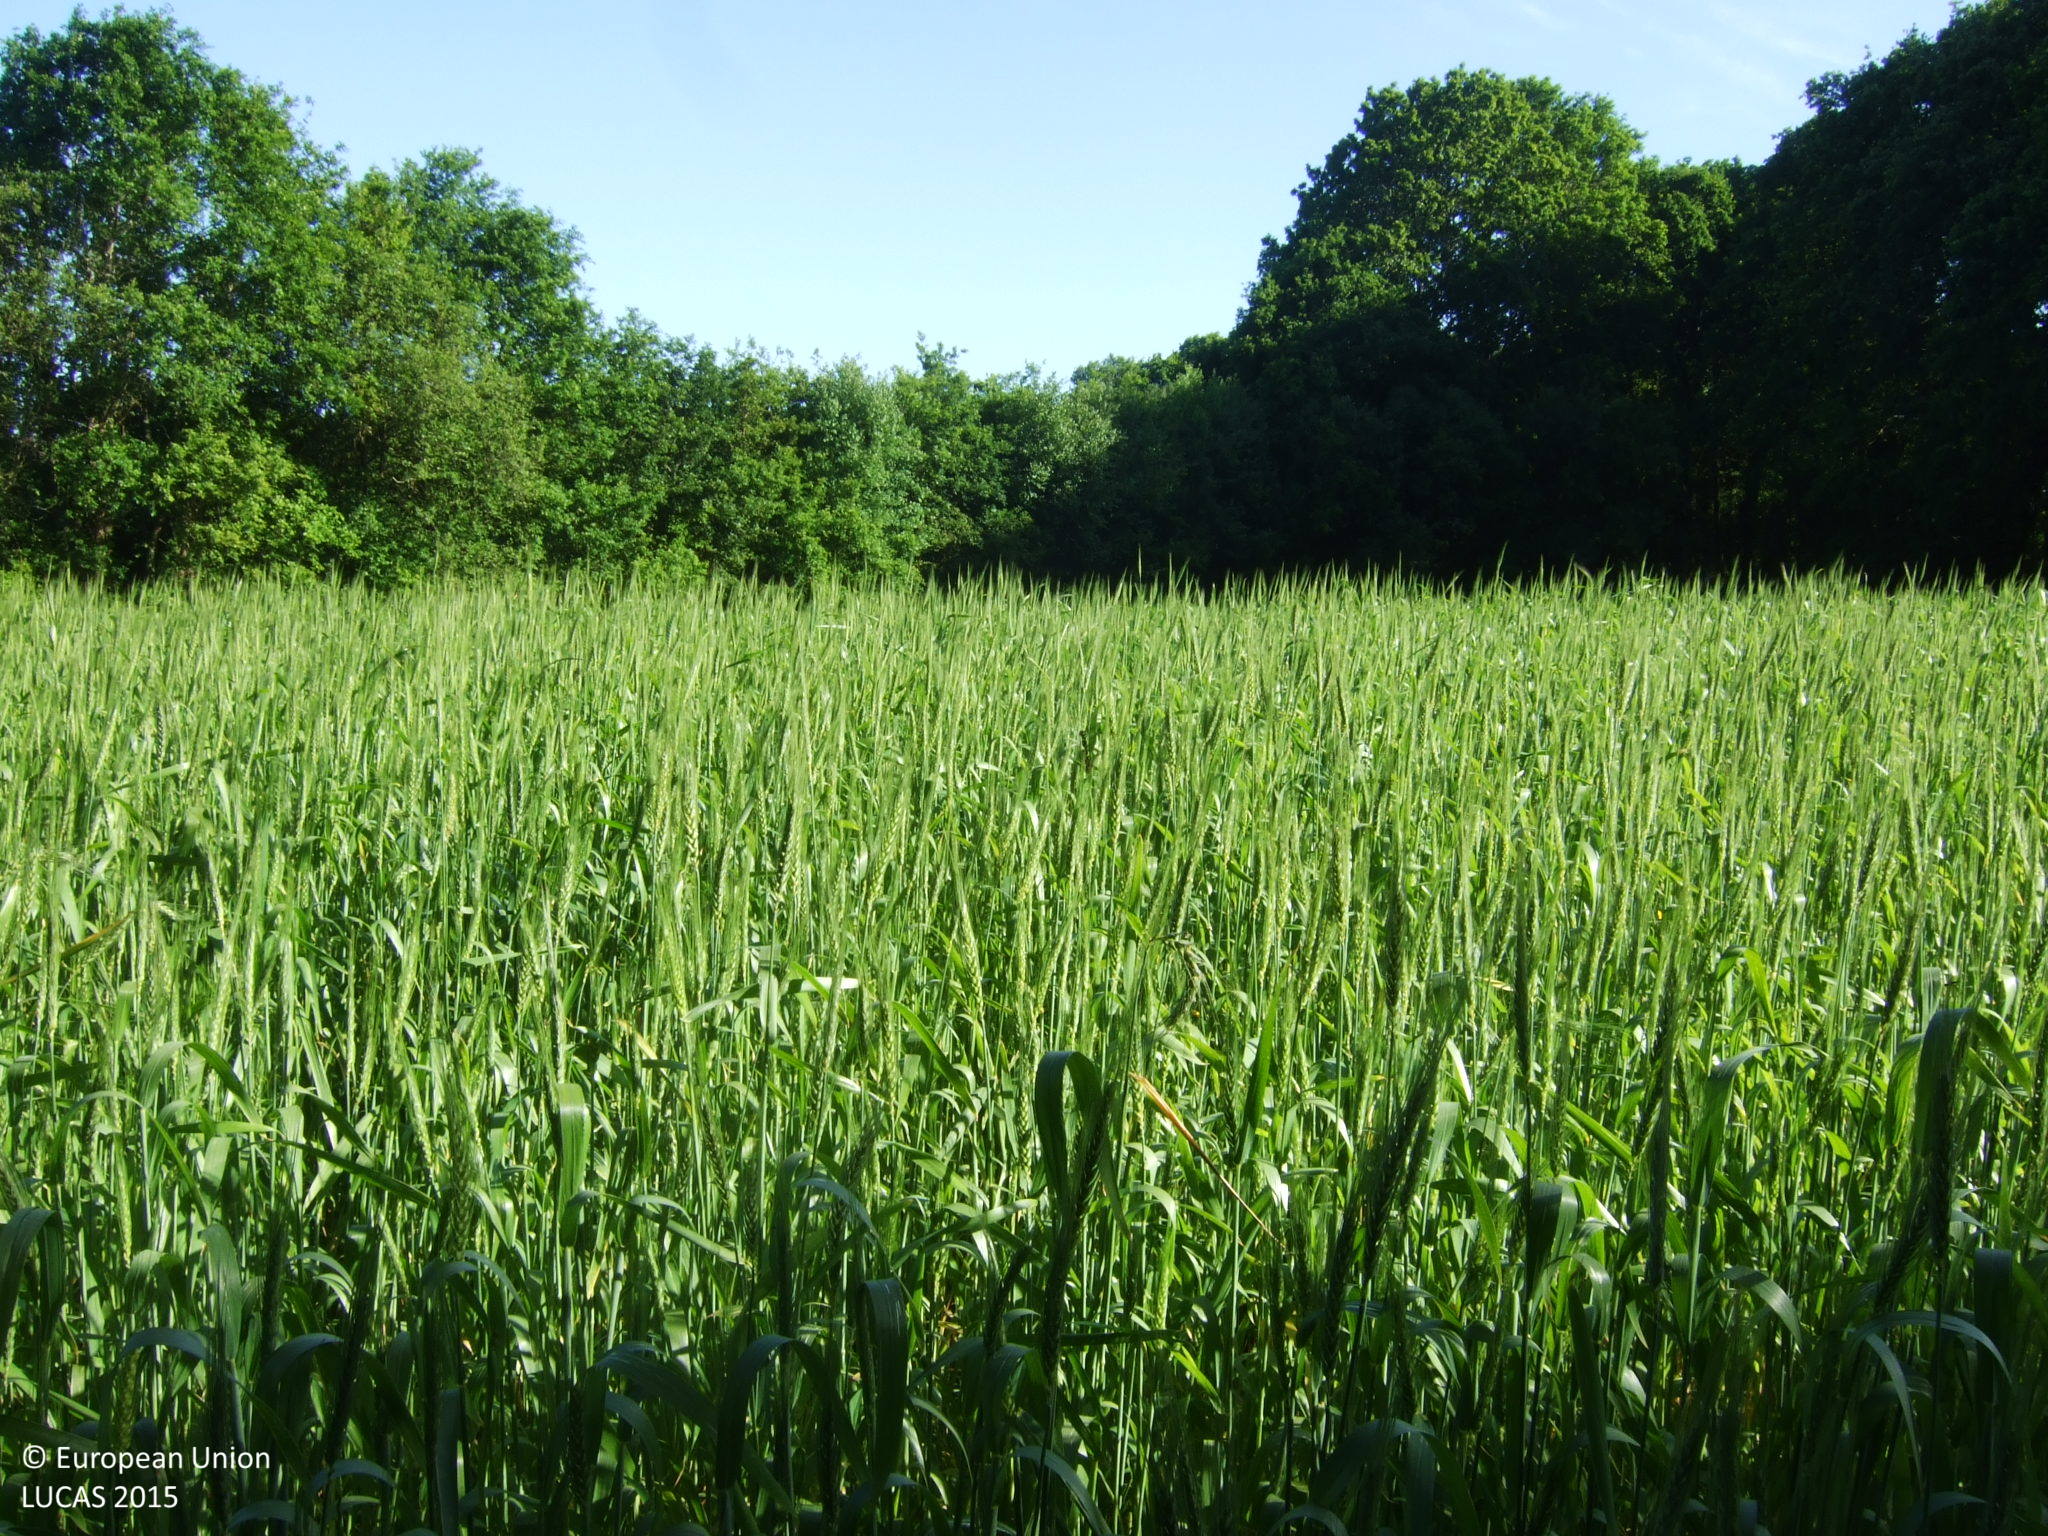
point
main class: Cropland
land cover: Common wheat
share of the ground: > 75 %
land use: Agriculture (excluding fallow land and kitchen gardens)
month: May
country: ES
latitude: 43.1755
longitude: -7.6362
